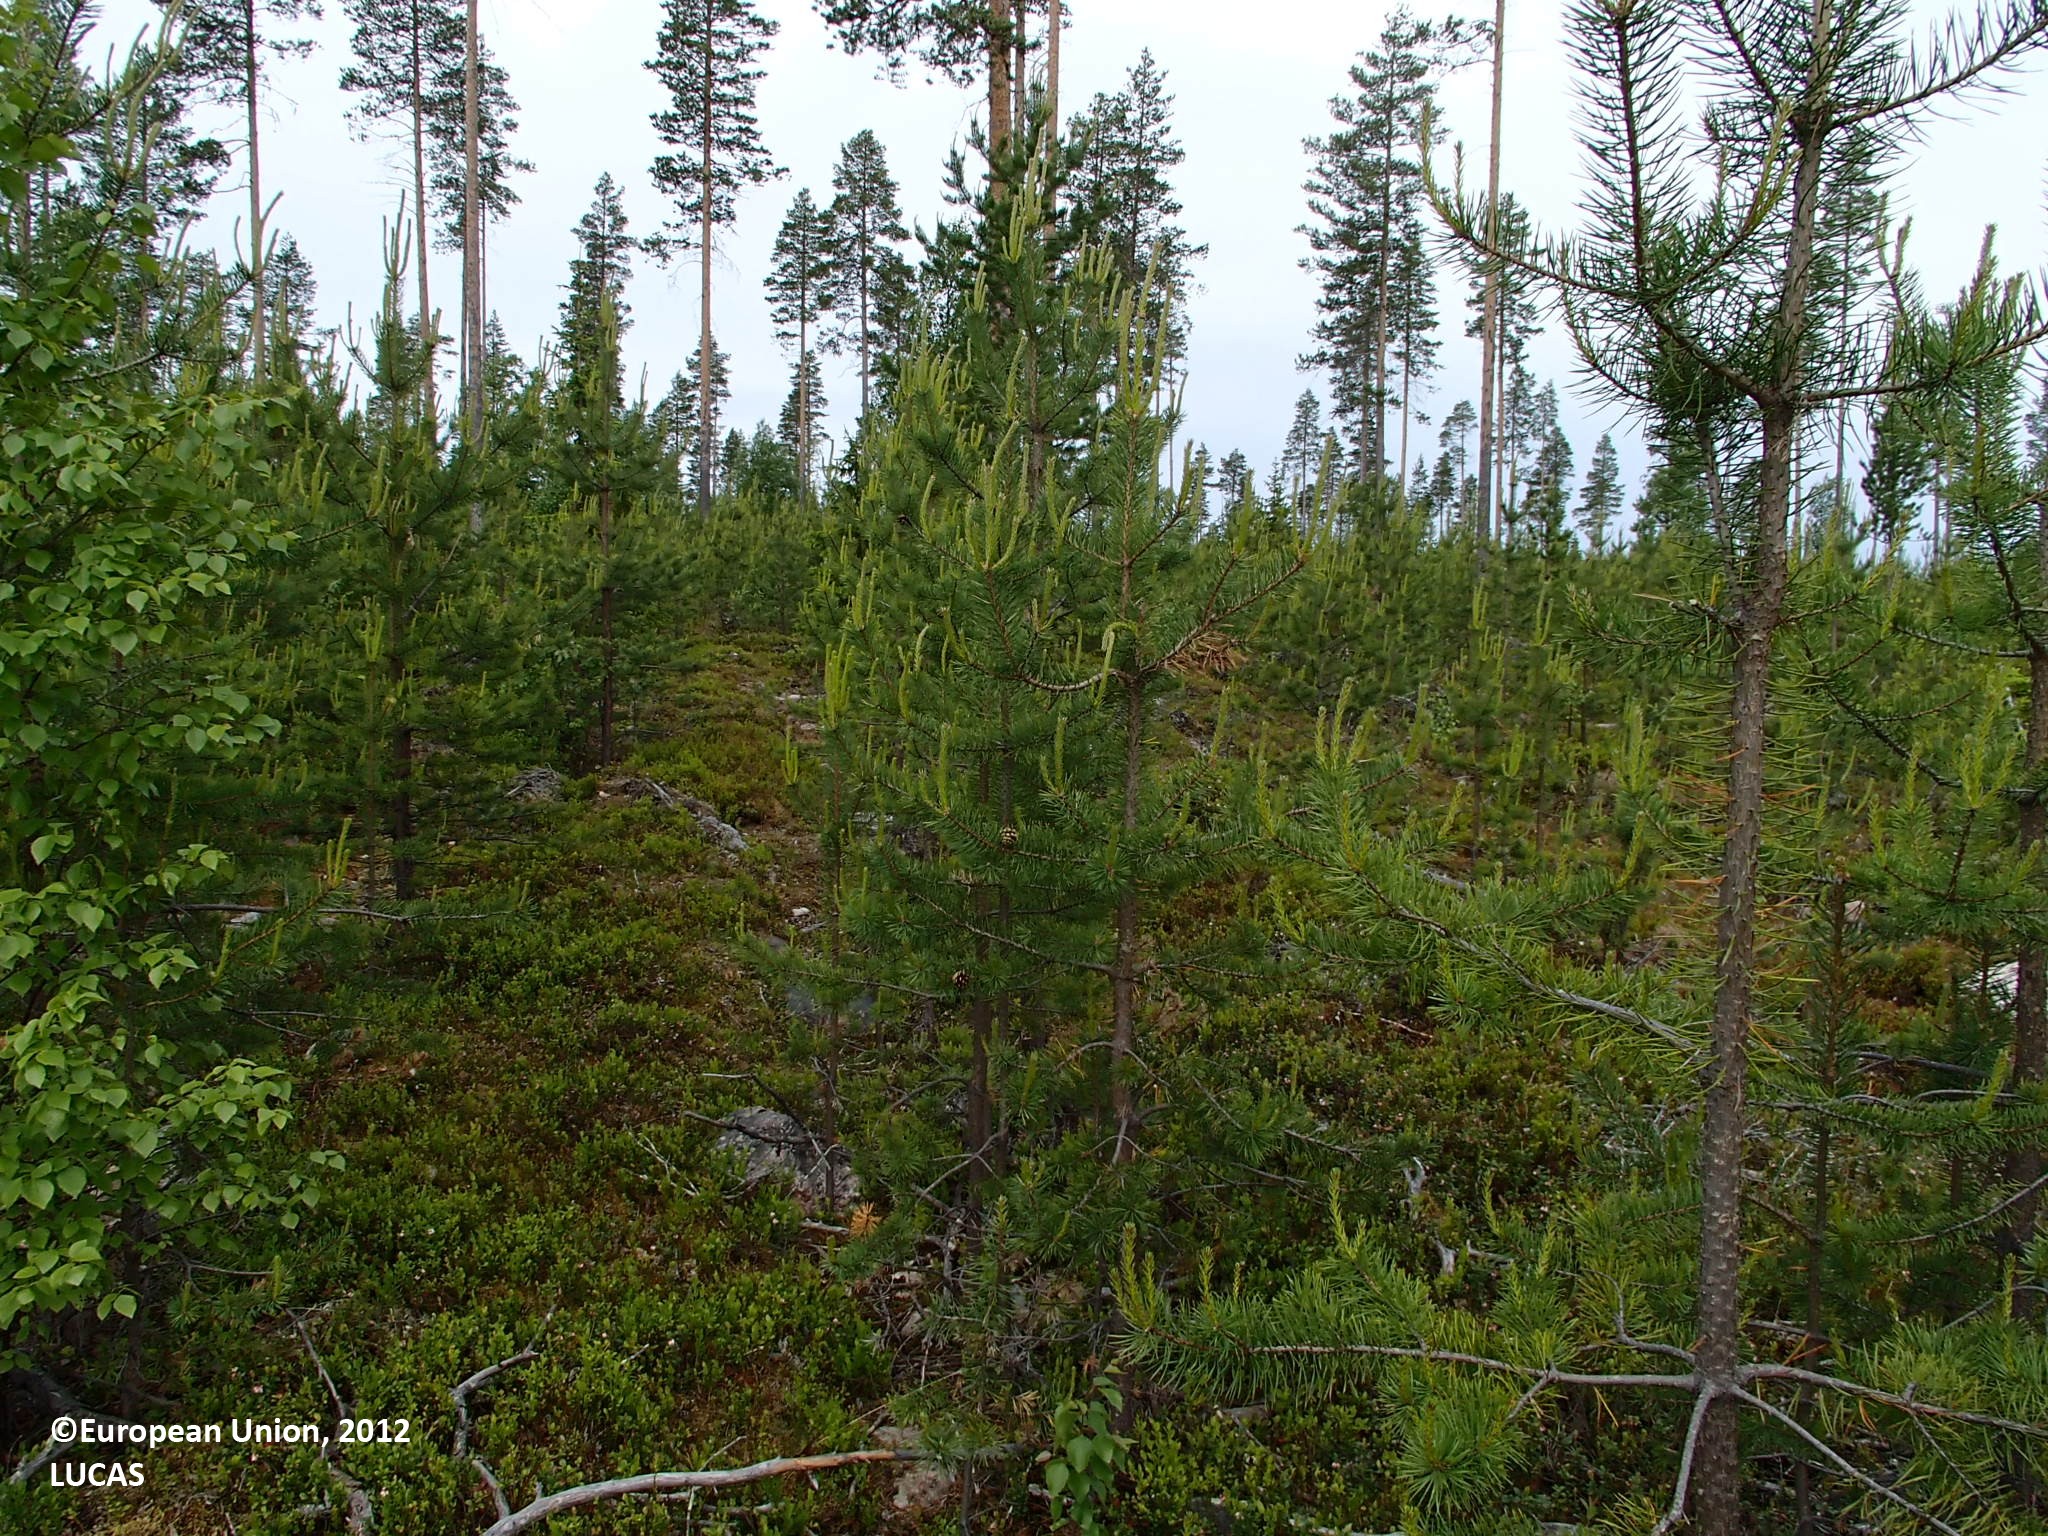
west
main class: Woodland
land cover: Pine dominated coniferous woodland
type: boreal forest
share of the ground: 10 - 25 %
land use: Forestry
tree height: > 5 m
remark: Clear cut
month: June
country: FI
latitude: 66.8218
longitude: 27.5275
